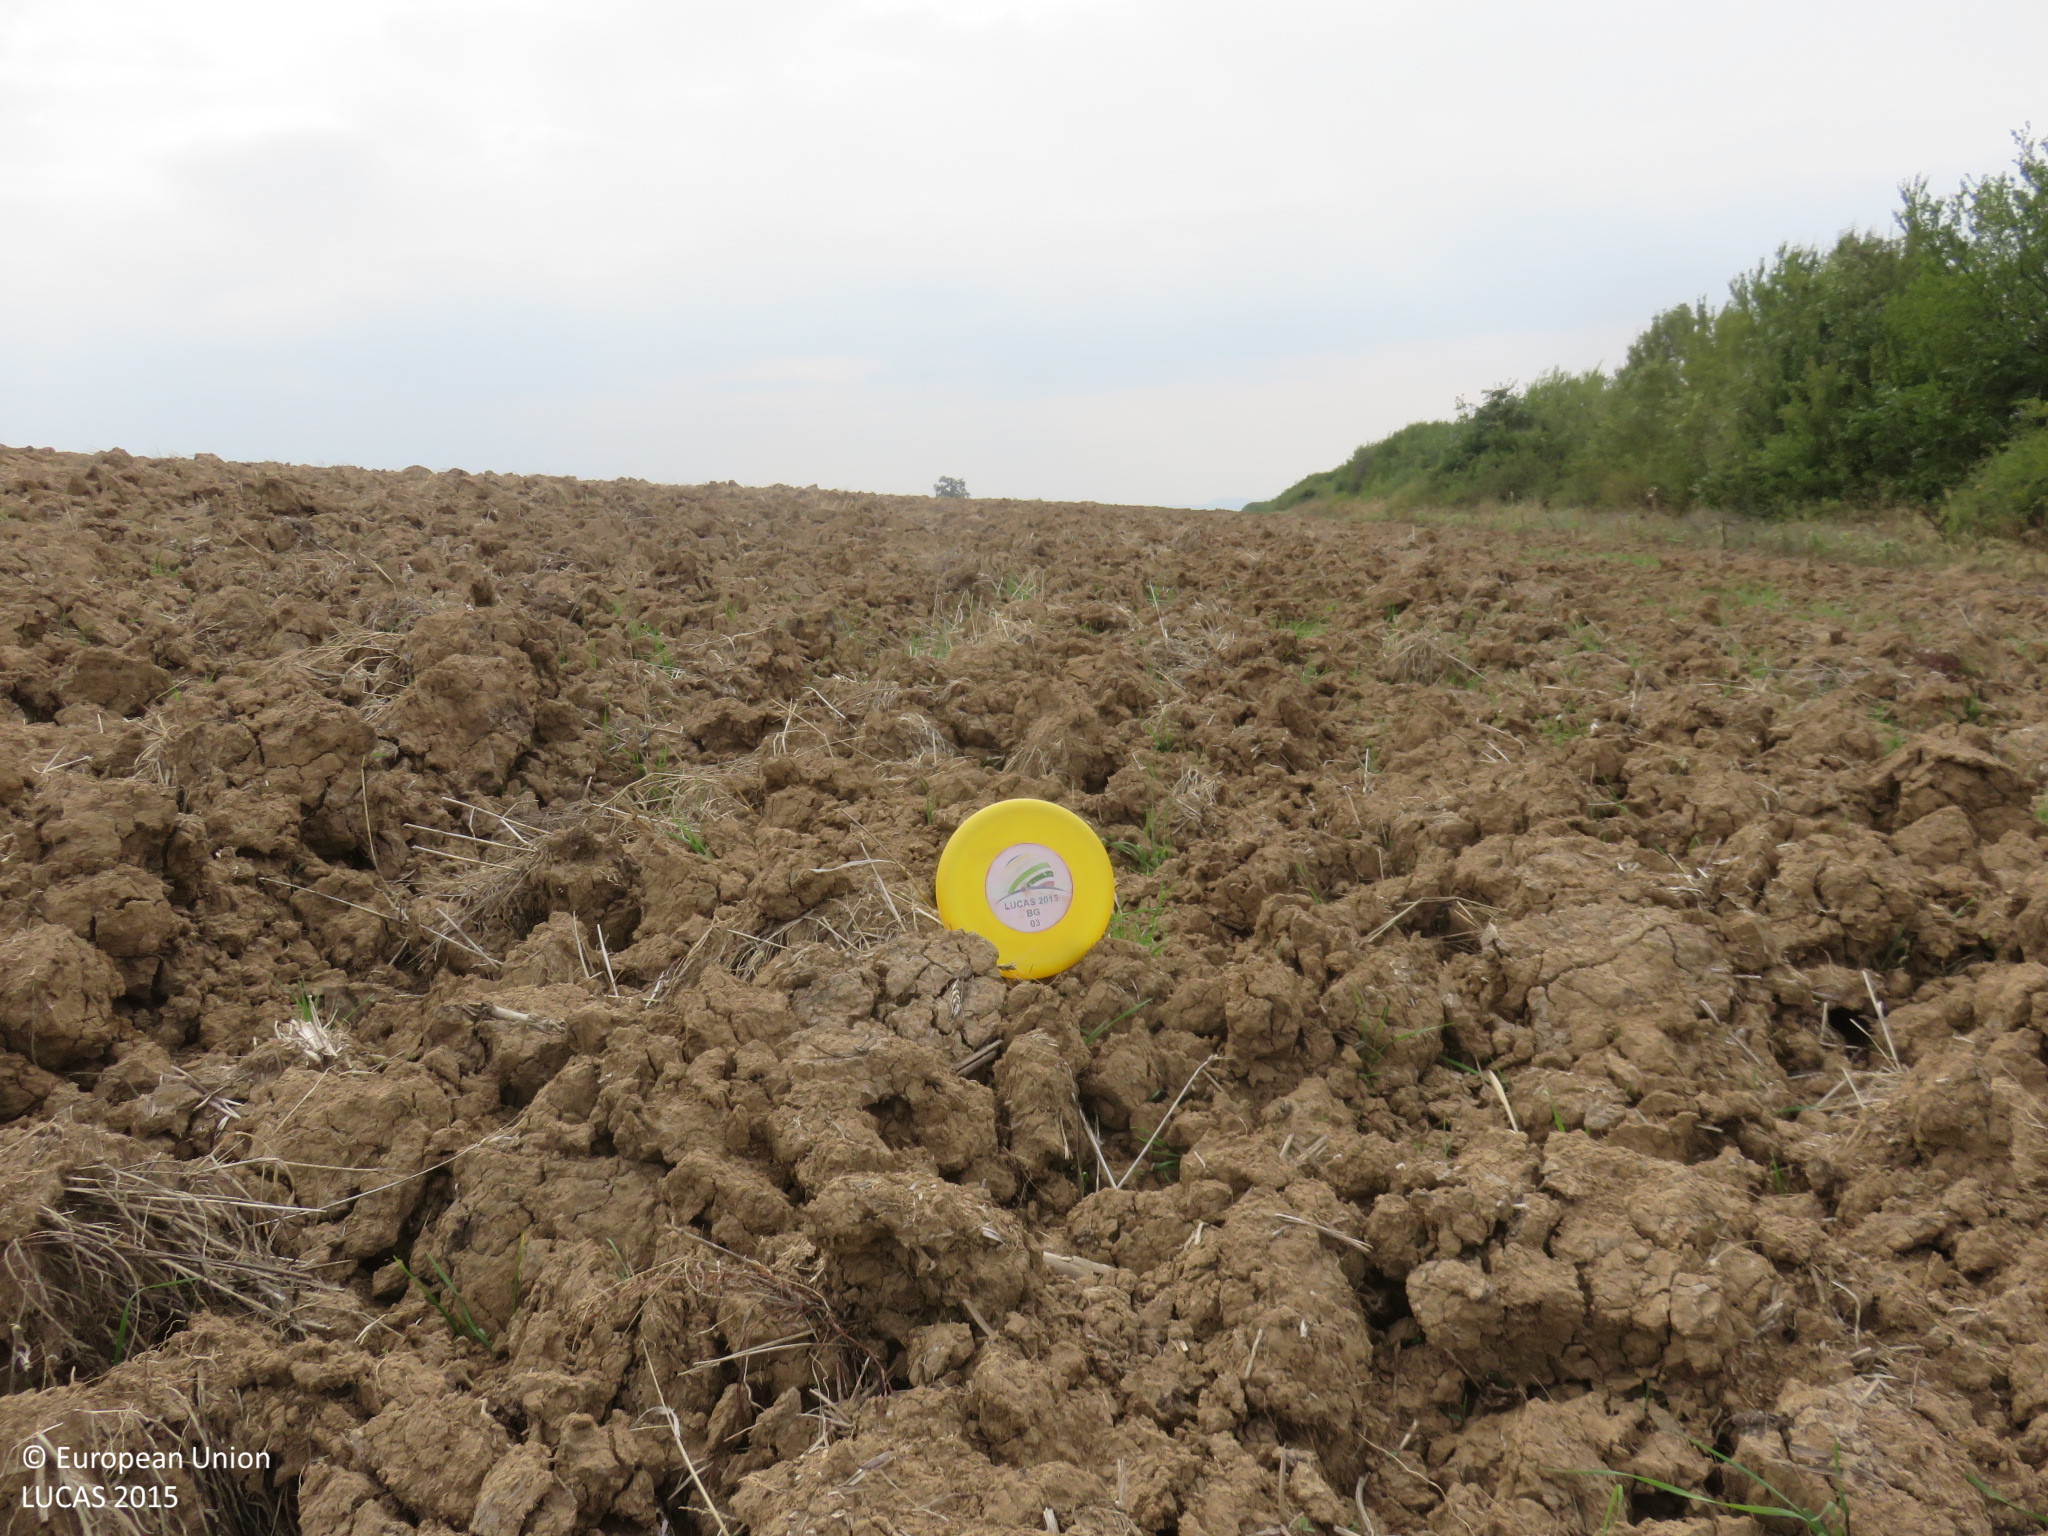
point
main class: Cropland
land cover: Common wheat
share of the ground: < 10 %
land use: Agriculture (excluding fallow land and kitchen gardens)
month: September
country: BG
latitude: 43.1635
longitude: 24.8611
